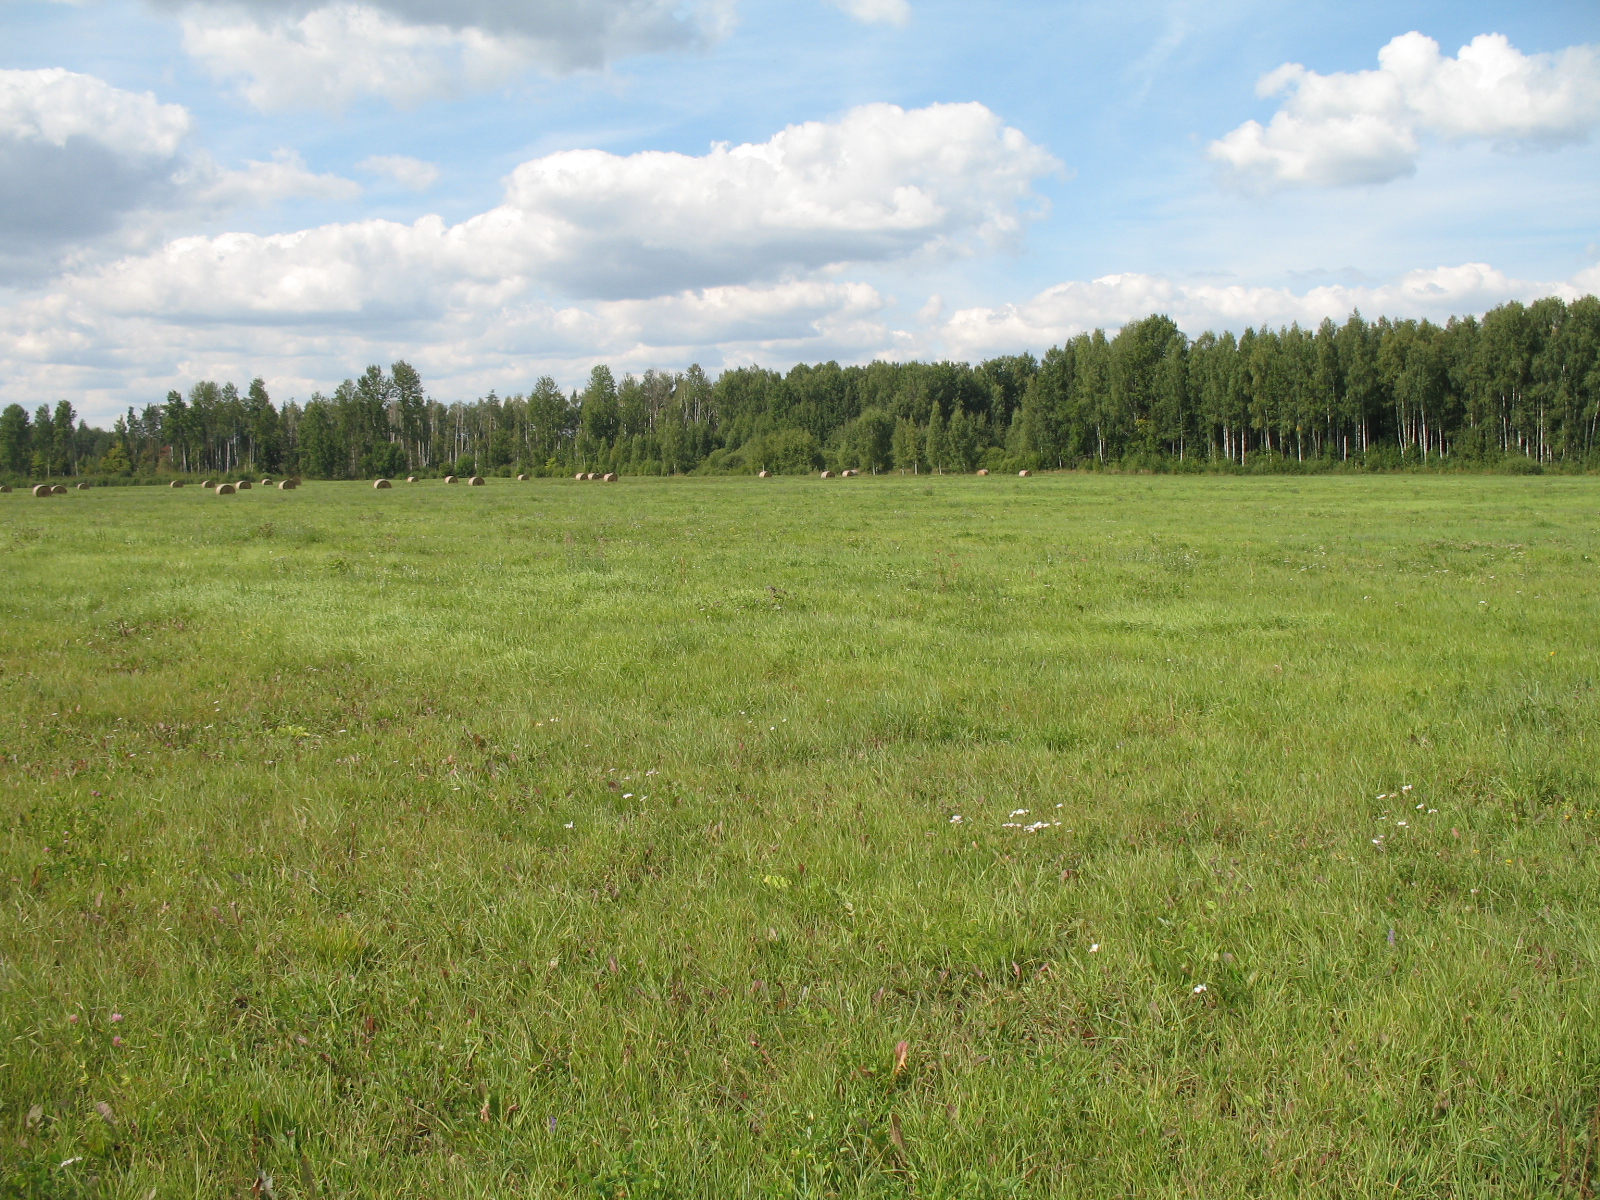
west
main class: Grassland
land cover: Grassland without tree/shrub cover
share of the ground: > 75 %
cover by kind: herbaceous plants 95 %, unconsolidated bare surface 5 %
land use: Agriculture (excluding fallow land and kitchen gardens)
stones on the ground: < 10 %
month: August
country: LV
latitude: 56.3372
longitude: 26.1029
